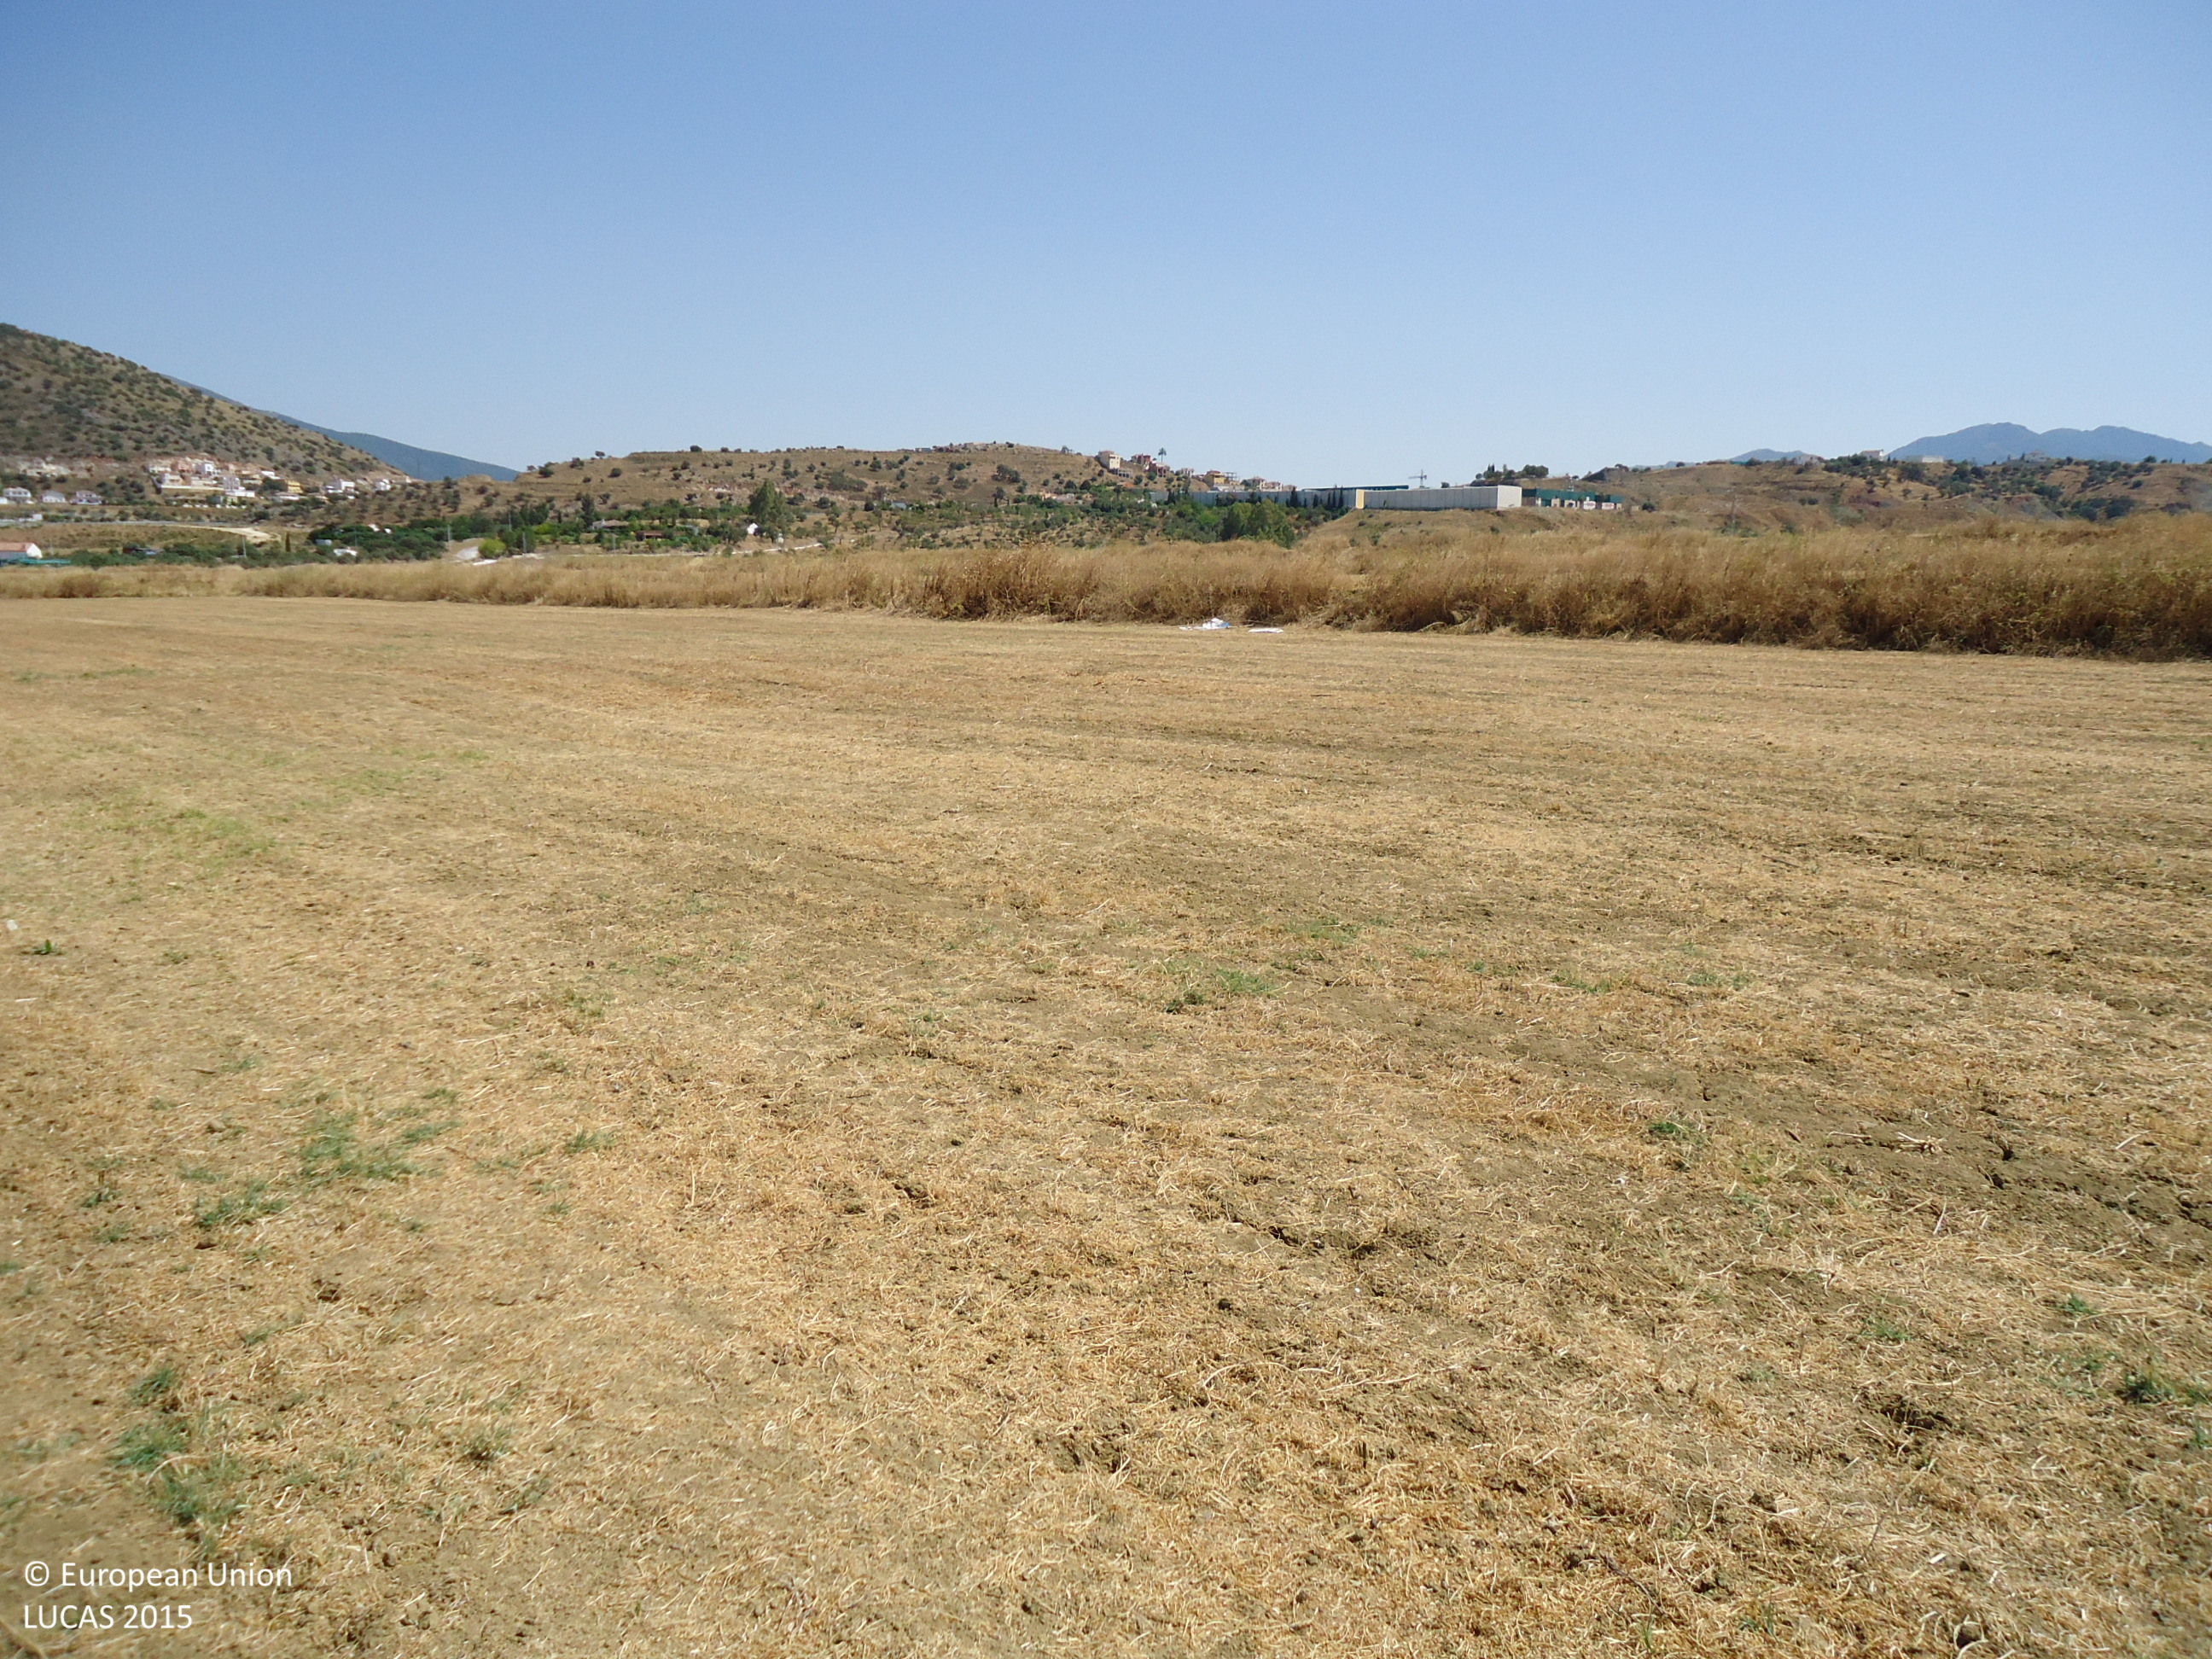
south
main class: Grassland
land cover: Spontaneously vegetated surfaces
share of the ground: > 75 %
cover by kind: herbaceous plants 90 %, unconsolidated bare surface 10 %
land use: Agriculture (excluding fallow land and kitchen gardens)
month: June
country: ES
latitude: 36.6854
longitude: -4.7314
